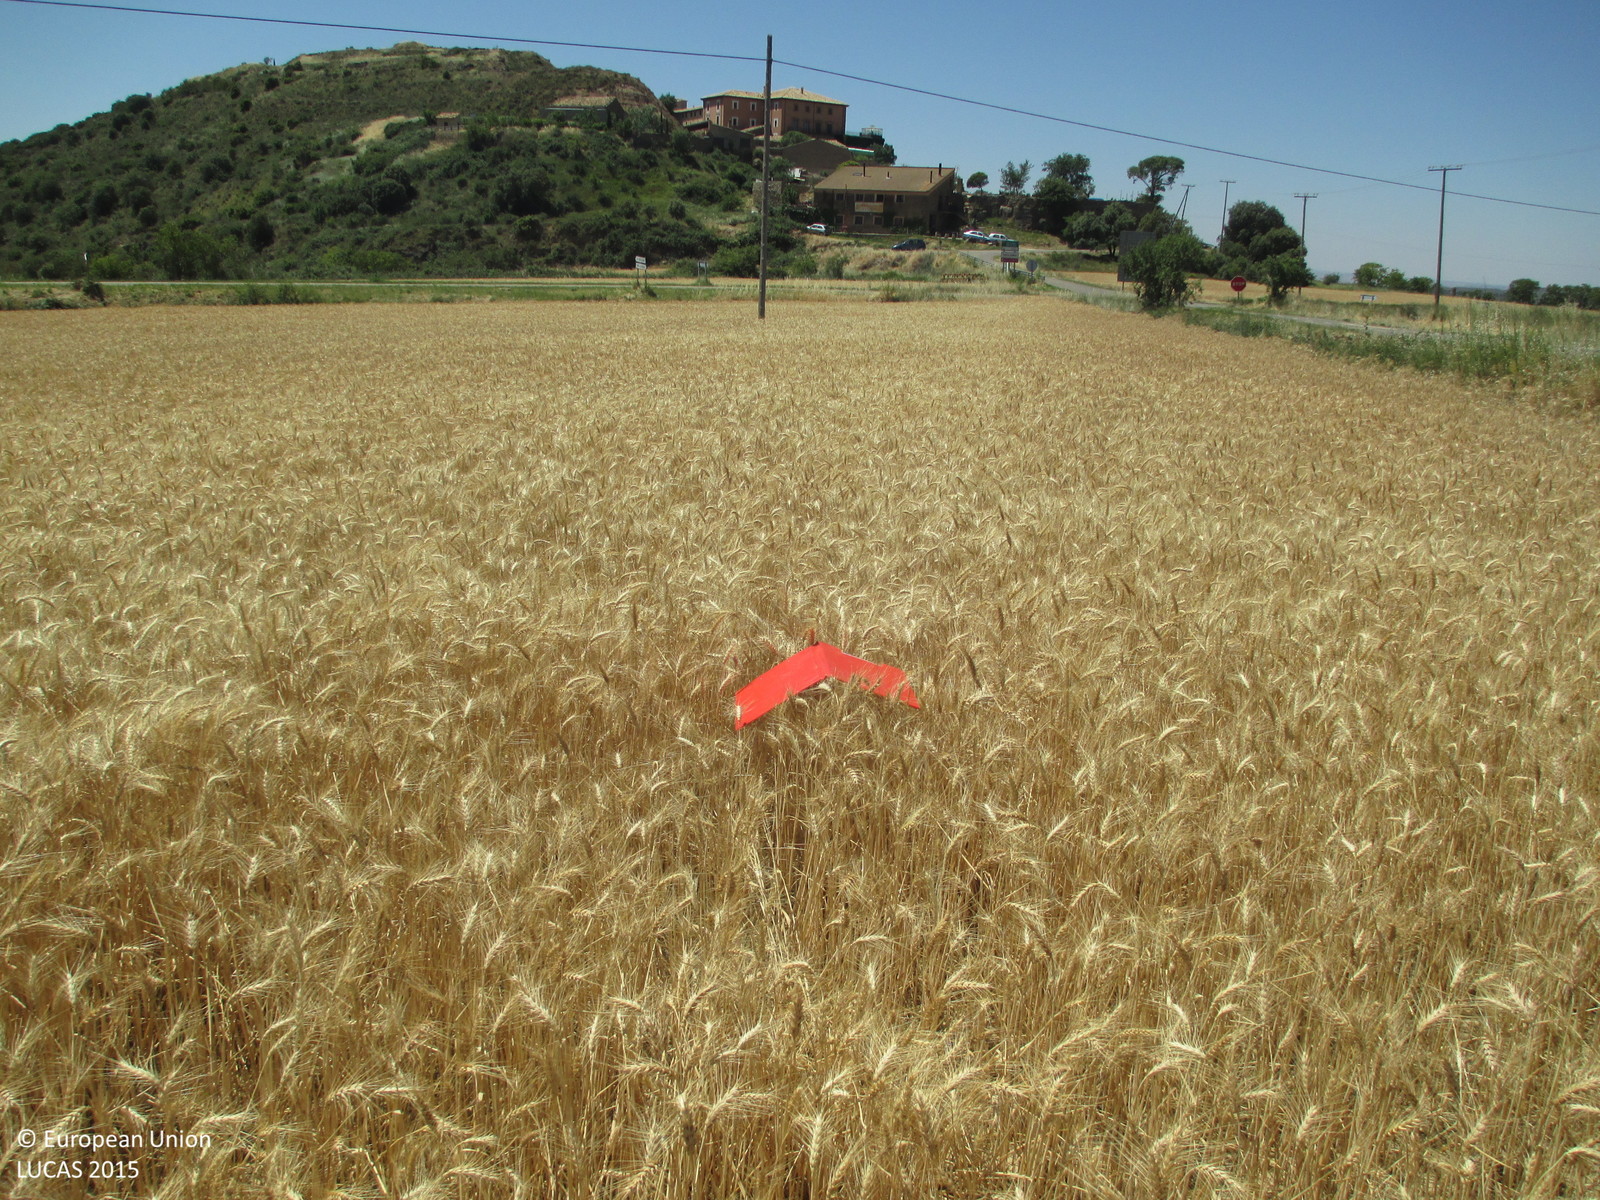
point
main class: Cropland
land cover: Durum wheat
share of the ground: > 75 %
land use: Agriculture (excluding fallow land and kitchen gardens)
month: June
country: ES
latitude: 42.1999
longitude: -0.3044
